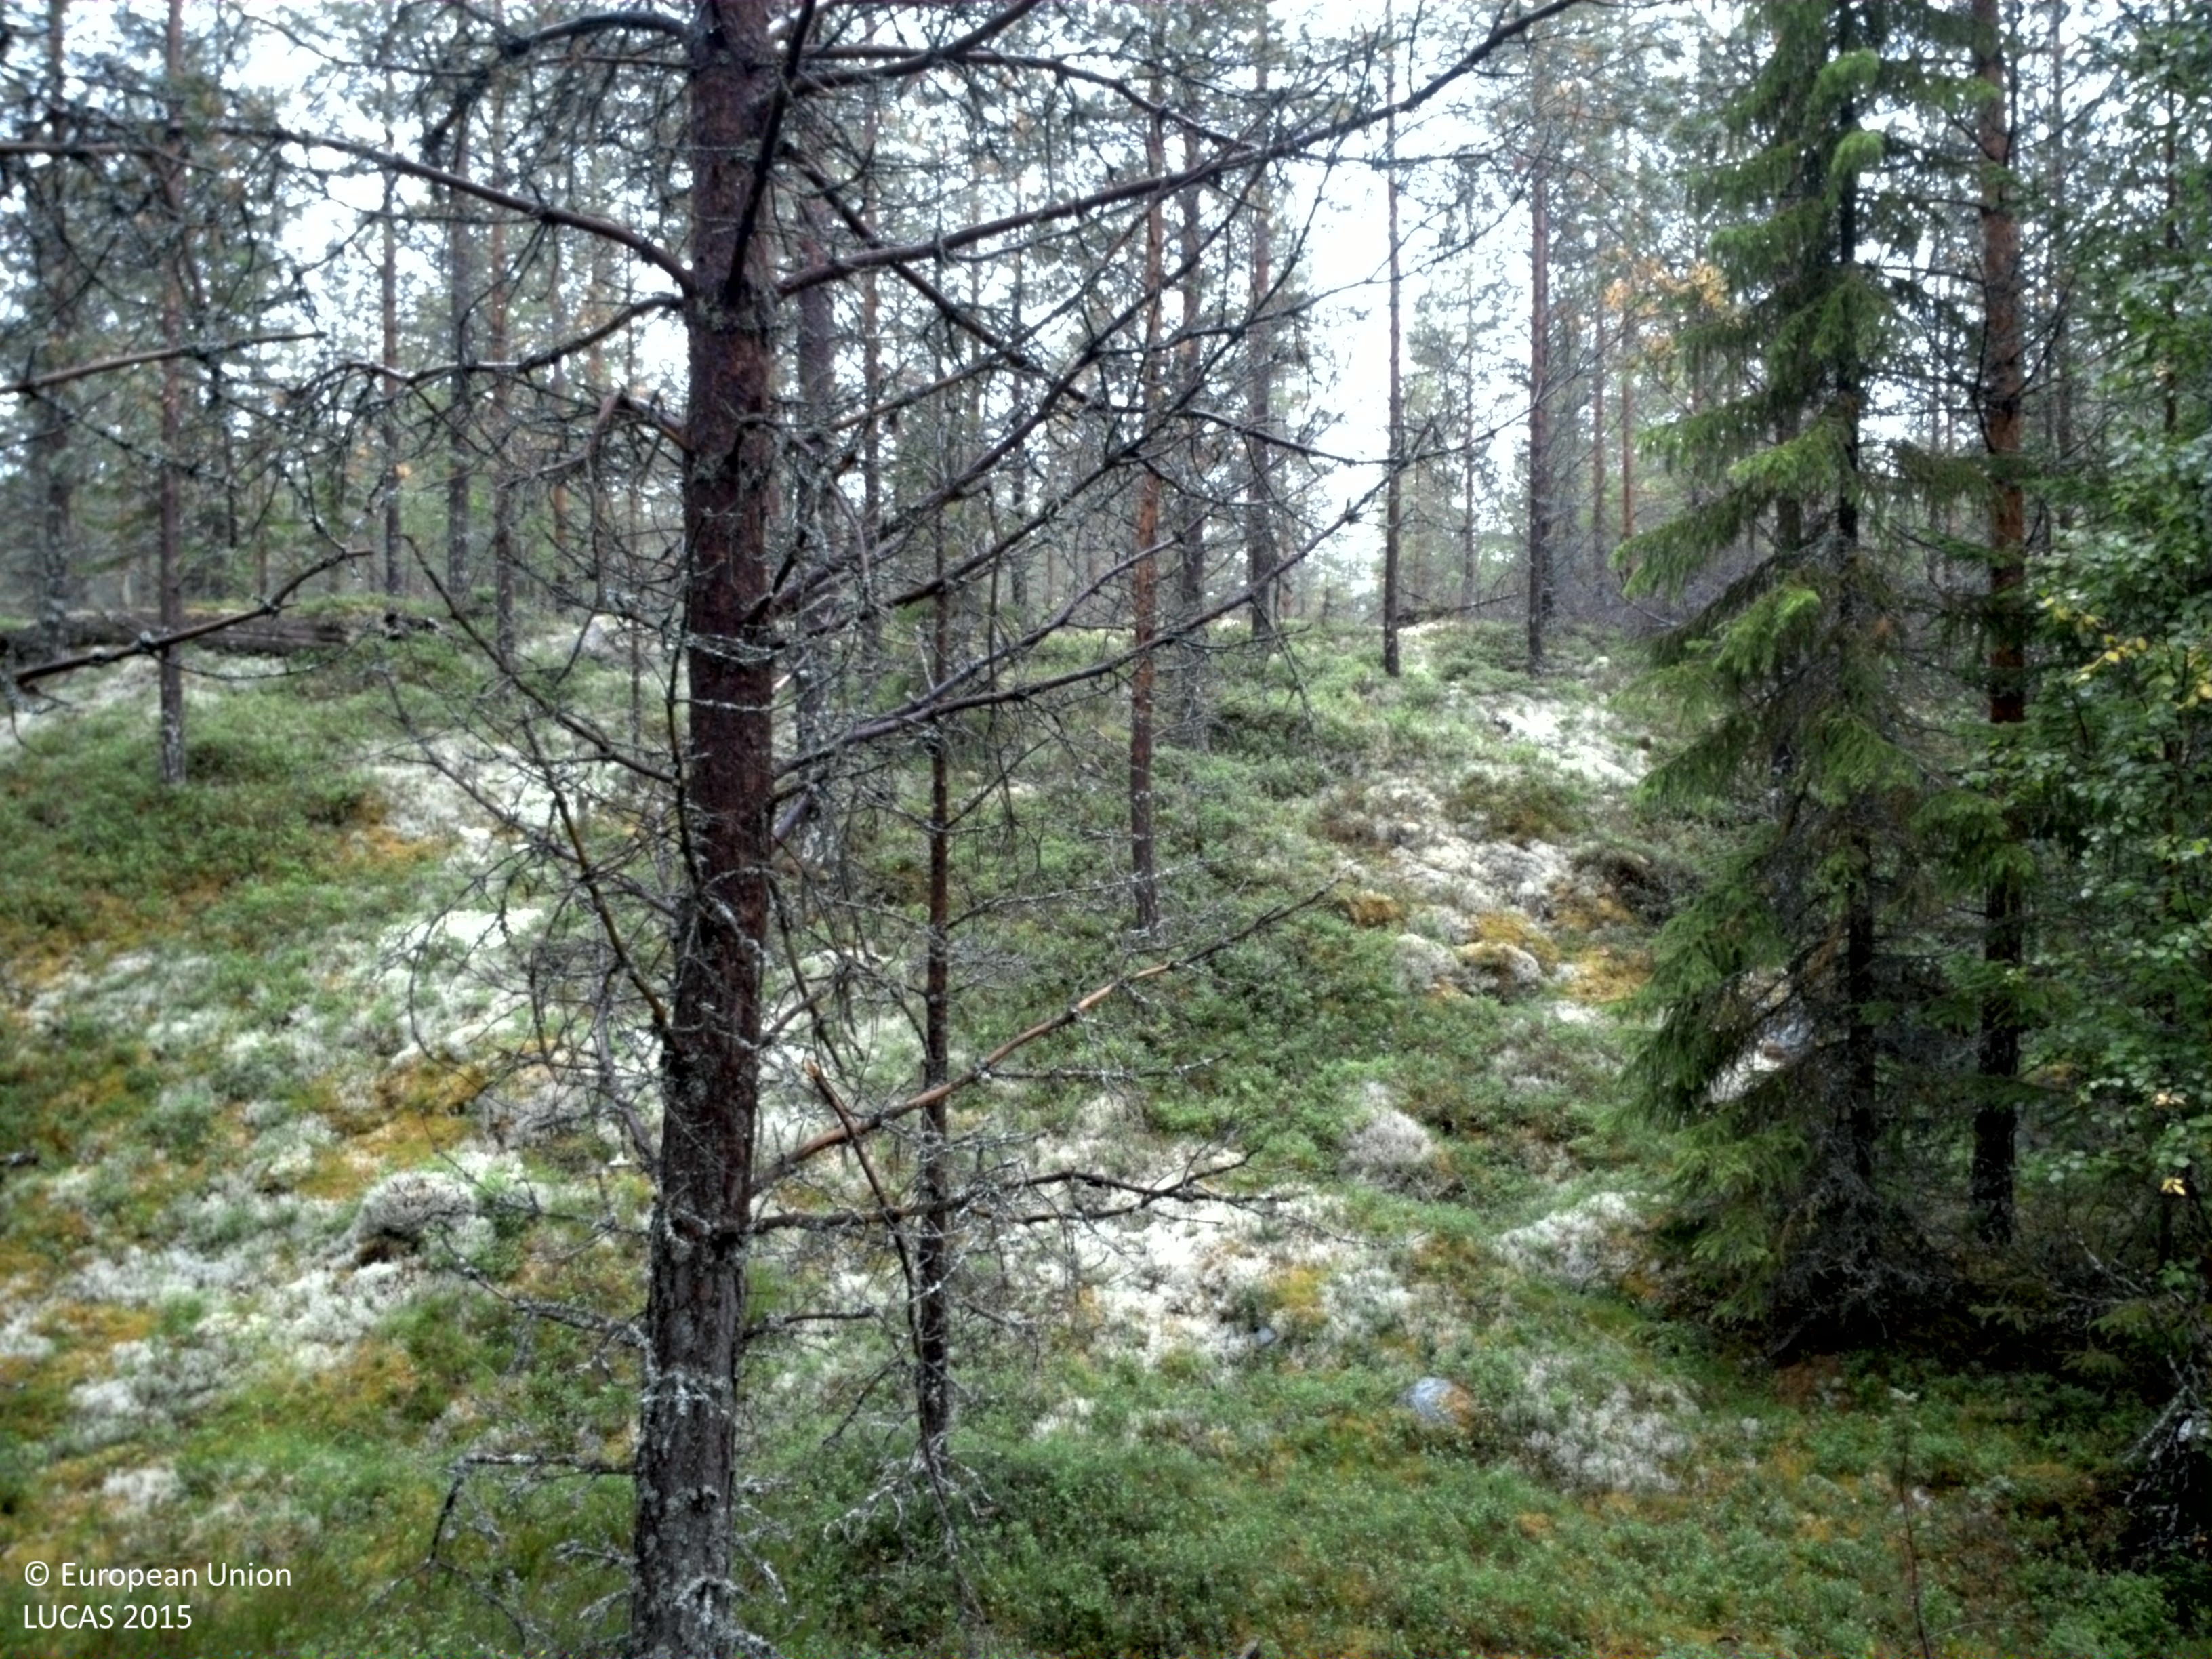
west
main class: Woodland
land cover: Pine dominated coniferous woodland
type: boreal forest
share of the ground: 50 - 75 %
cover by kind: coniferous forest trees 50 %, shrubs 25 %, lichens and mosses 15 %, broadleaved forest trees 10 %
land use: Forestry
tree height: > 5 m
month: August
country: SE
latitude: 61.7884
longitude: 15.0084
